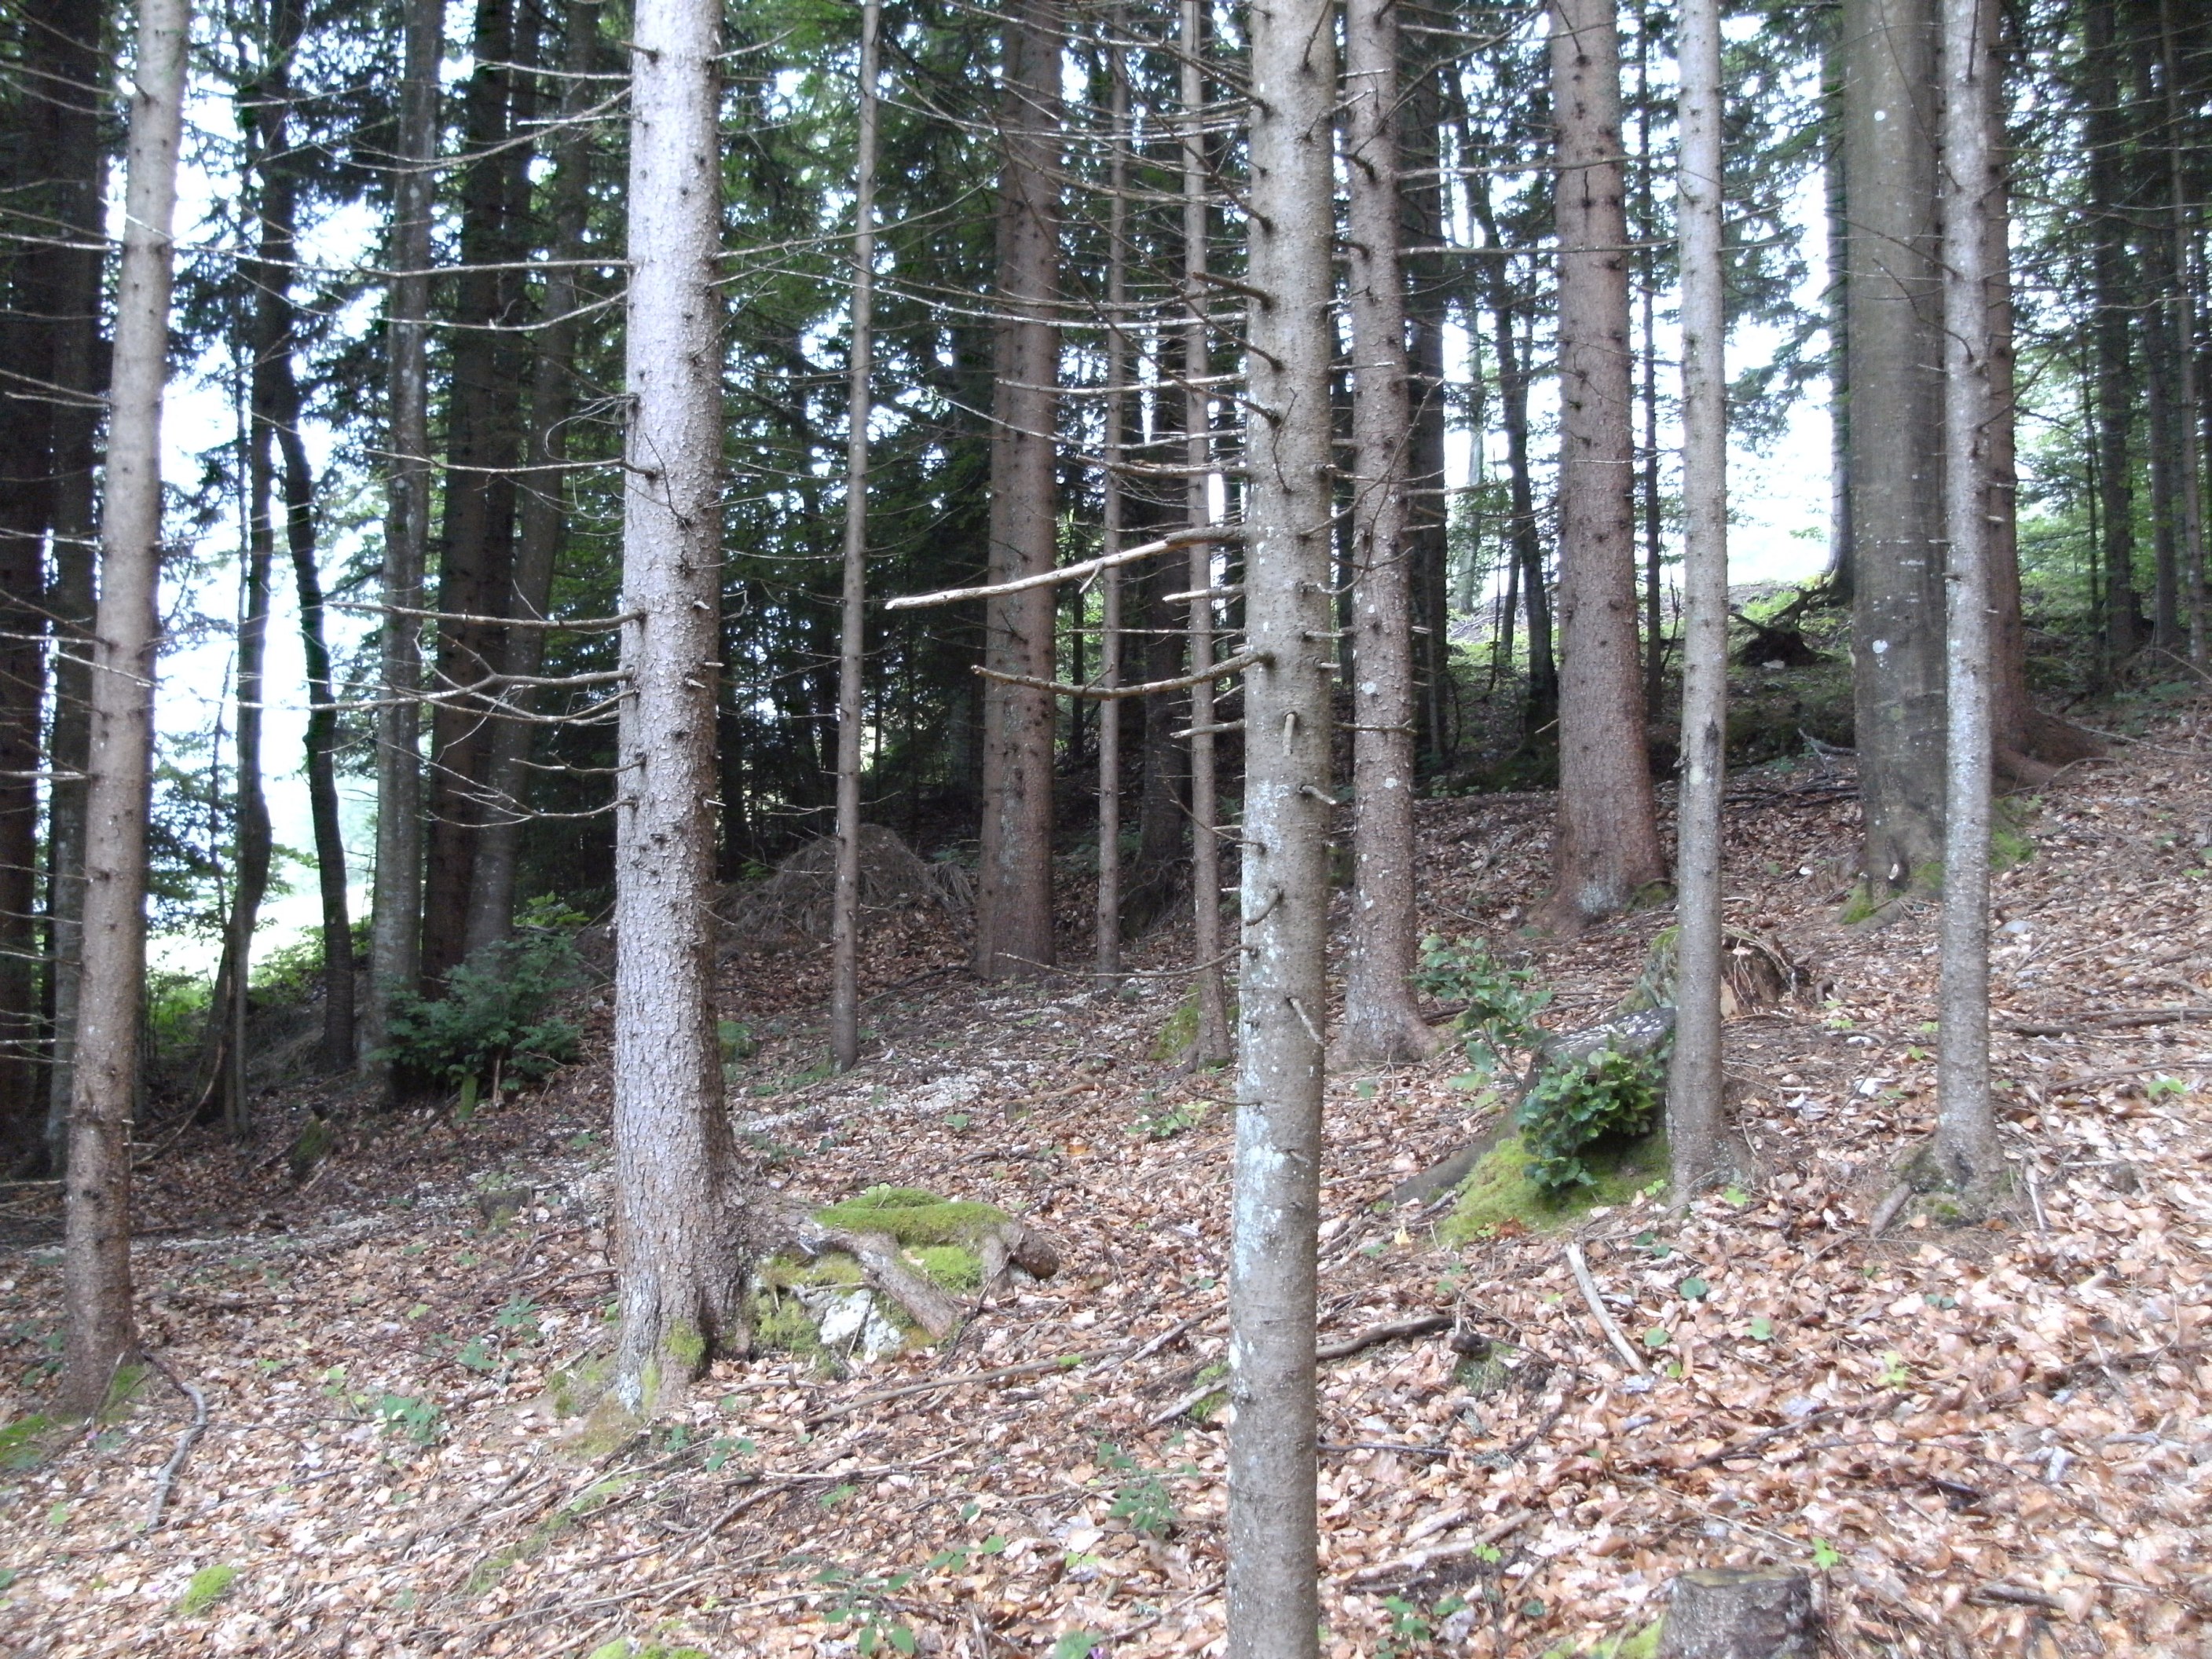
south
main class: Grassland
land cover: Spontaneously vegetated surfaces
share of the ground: > 75 %
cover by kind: herbaceous plants 100 %
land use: Forestry
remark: Clear cut
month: July
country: AT
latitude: 46.5295
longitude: 14.4431
